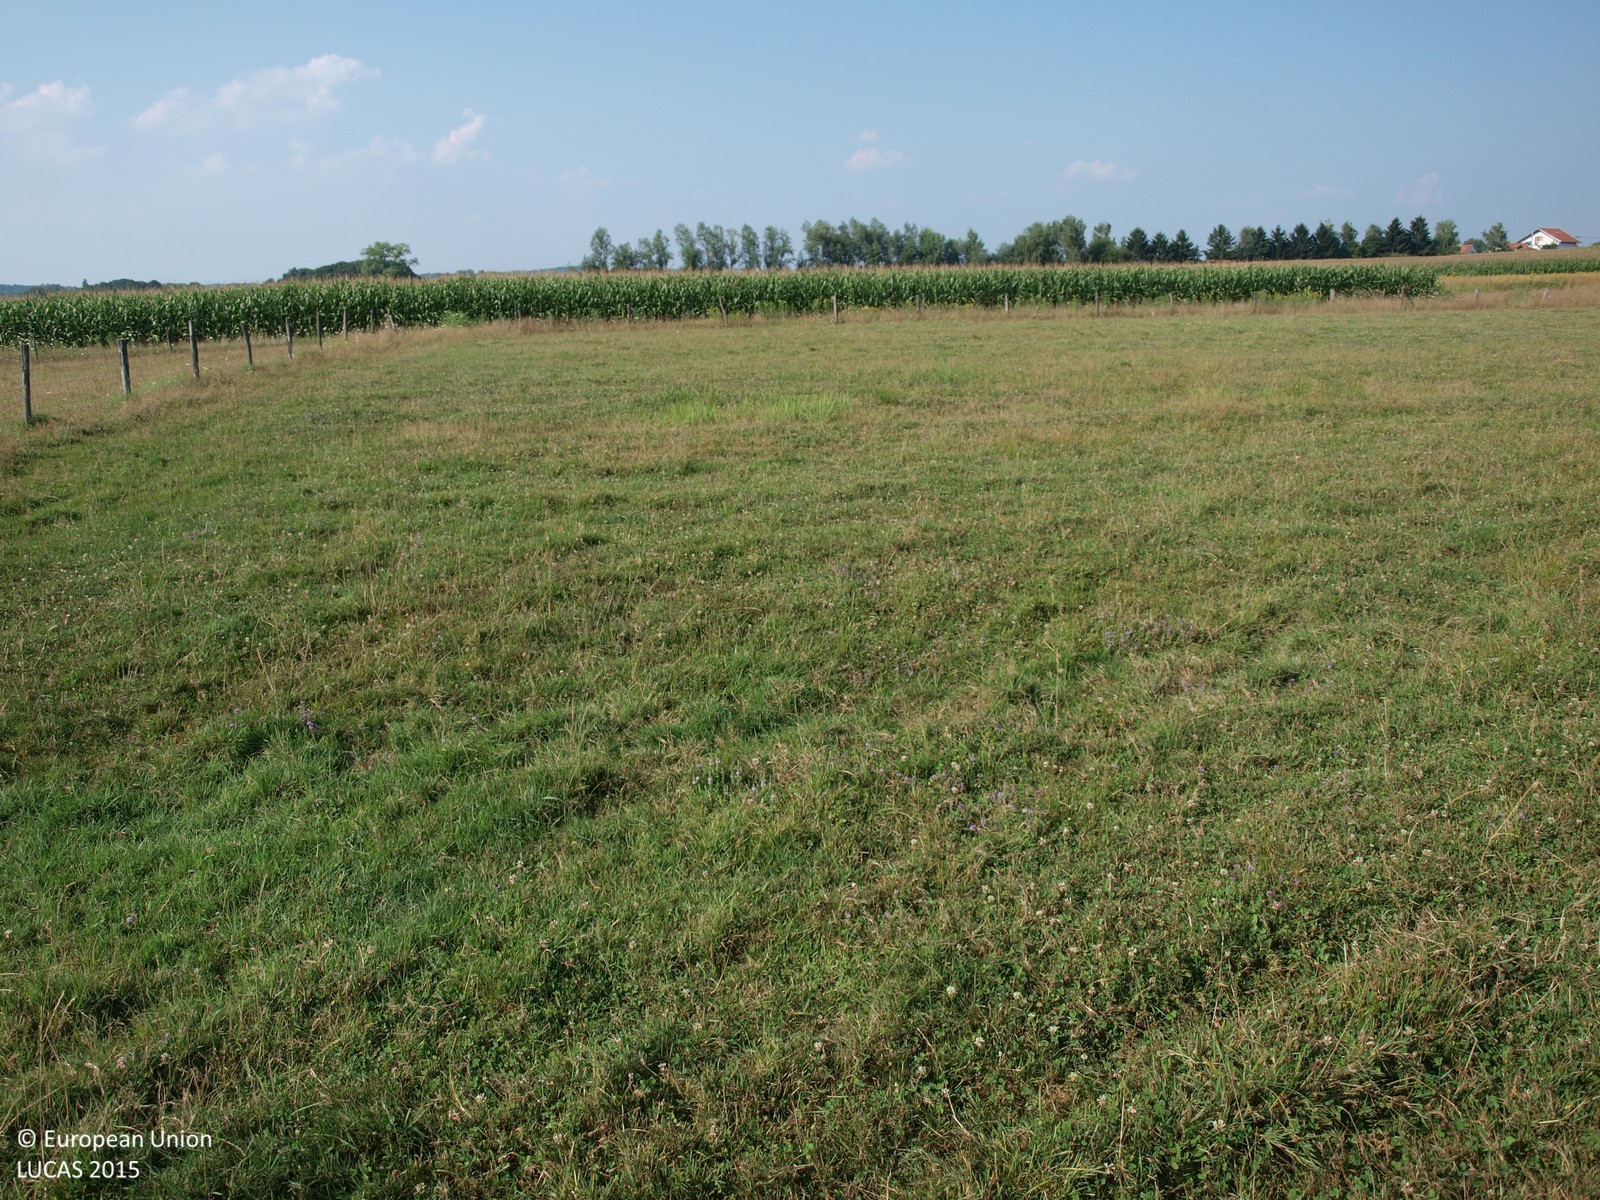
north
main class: Grassland
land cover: Grassland without tree/shrub cover
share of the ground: > 75 %
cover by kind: herbaceous plants 100 %
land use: Agriculture (excluding fallow land and kitchen gardens)
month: August
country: HR
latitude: 45.8446
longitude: 16.5277
